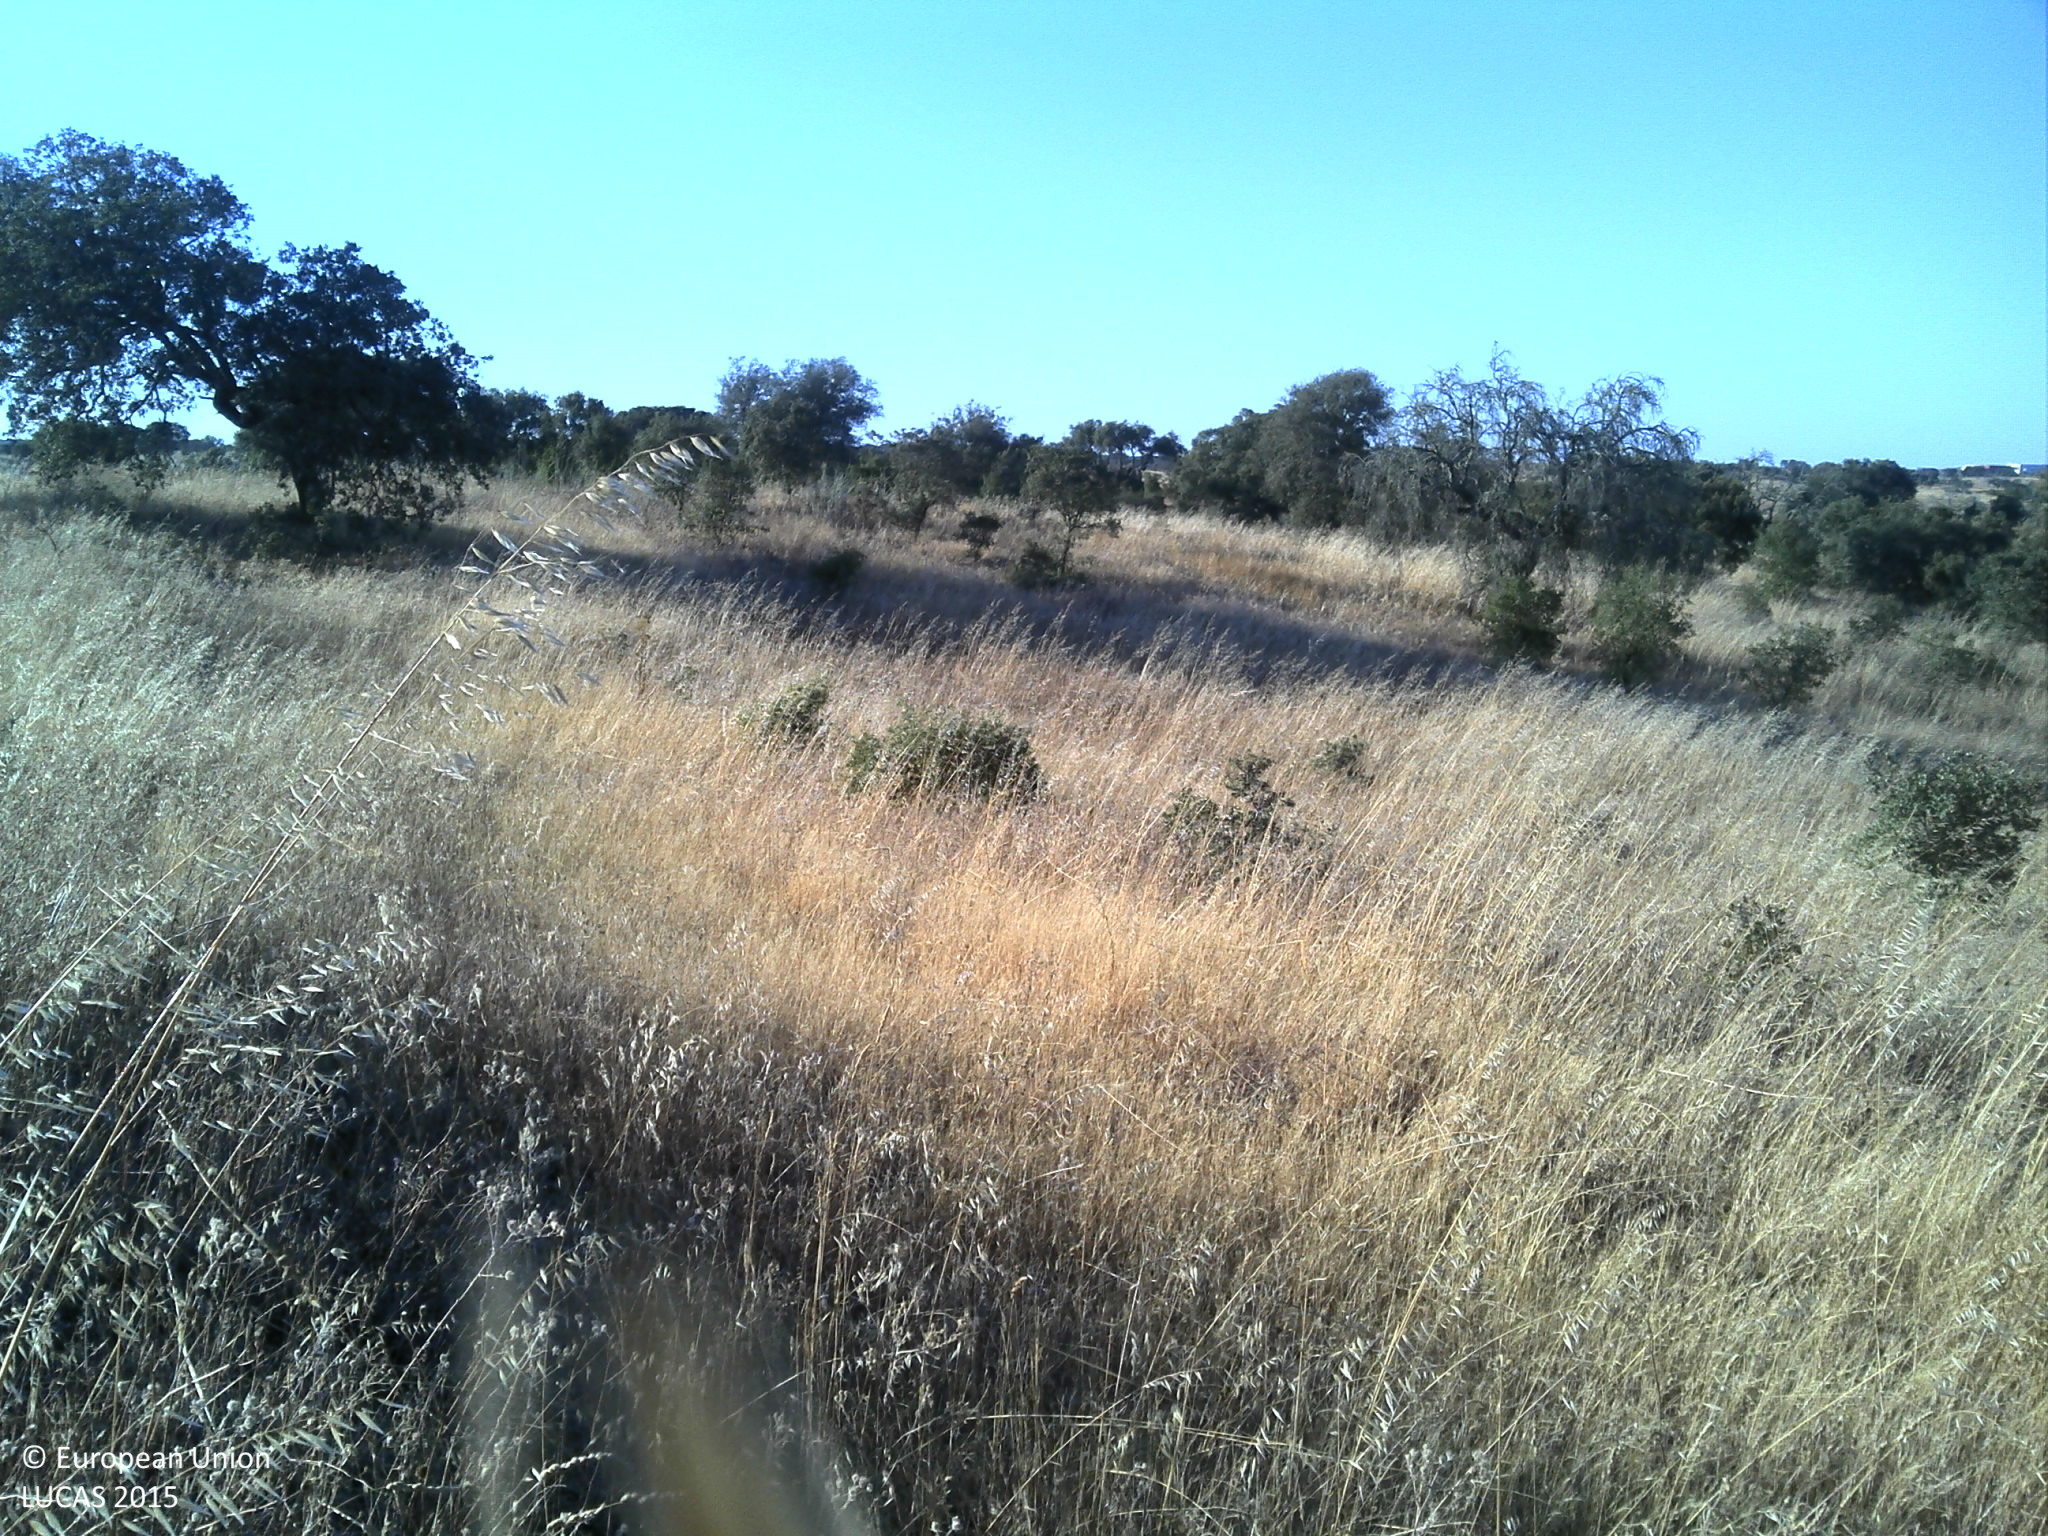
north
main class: Woodland
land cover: Broadleaved woodland
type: broadleaved evergreen forest
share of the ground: 10 - 25 %
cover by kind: herbaceous plants 65 %, broadleaved forest trees 25 %, unconsolidated bare surface 10 %
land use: Forestry
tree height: < 5 m
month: July
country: PT
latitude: 37.8785
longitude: -7.9331
